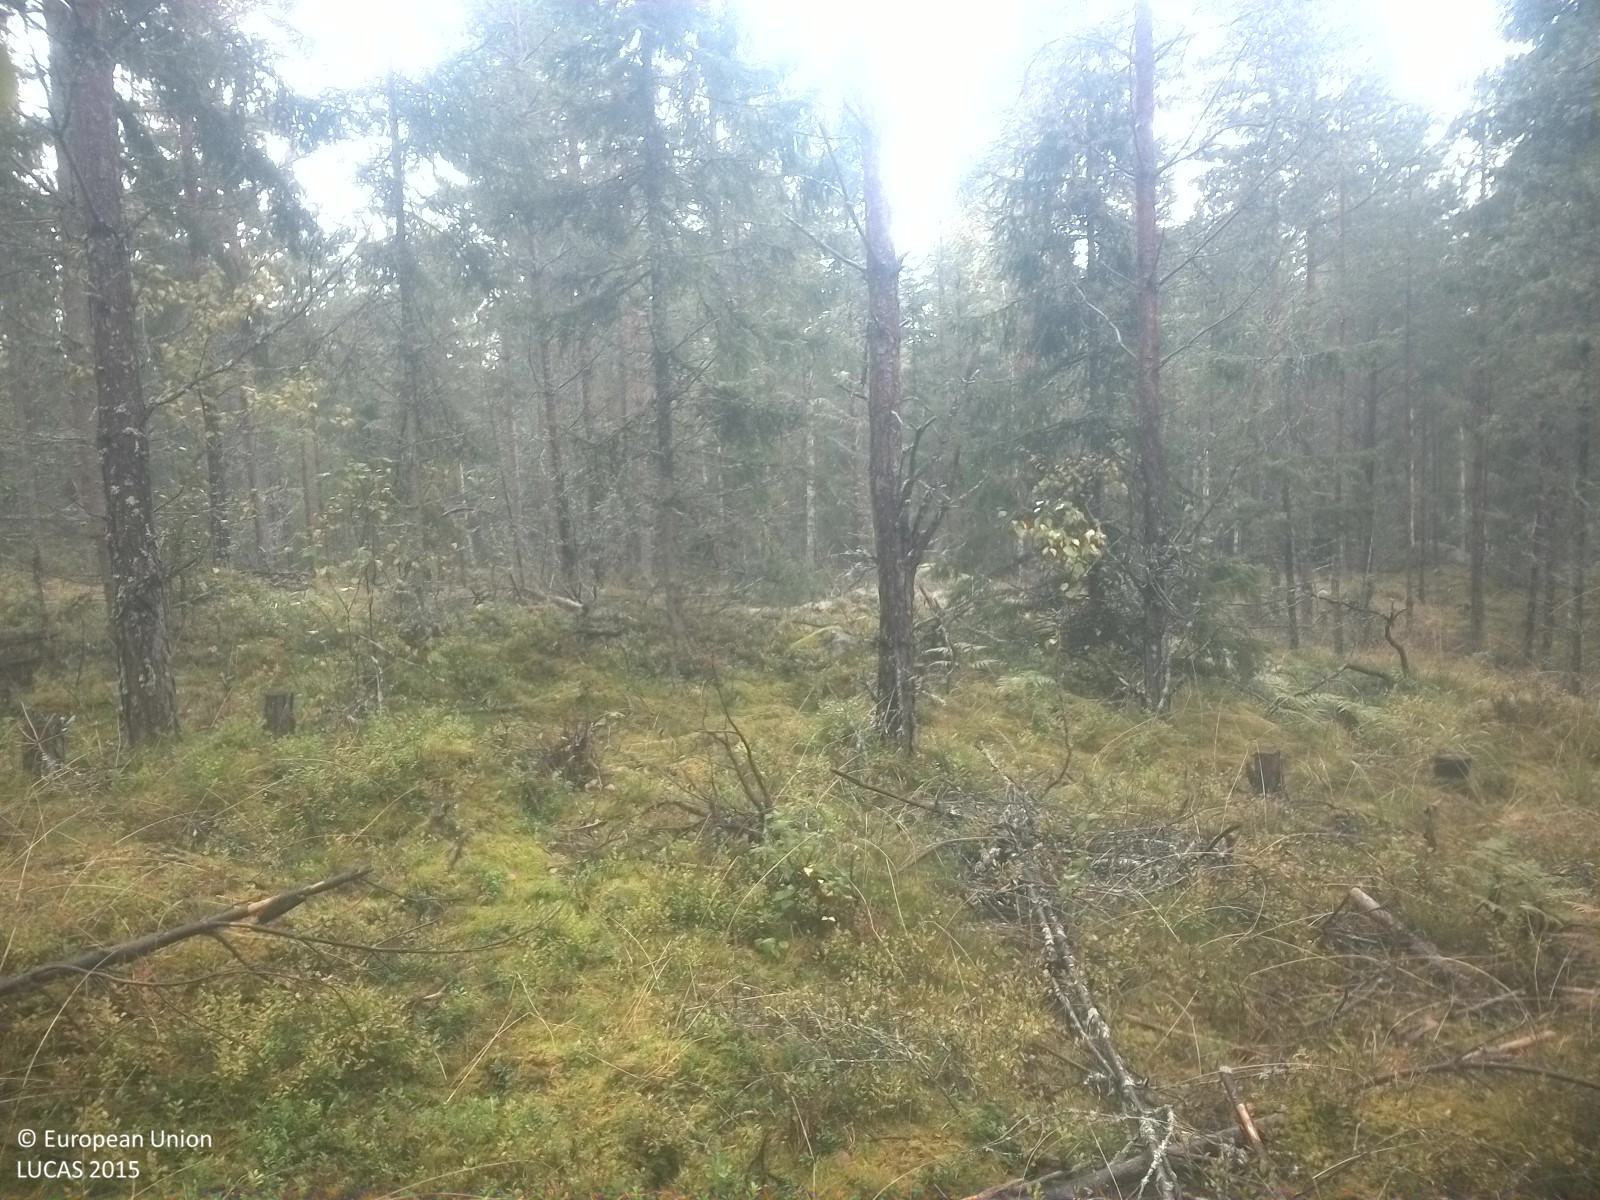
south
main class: Woodland
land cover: Other mixed woodland
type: boreal forest
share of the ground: 25 - 50 %
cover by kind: herbaceous plants 35 %, coniferous forest trees 25 %, lichens and mosses 25 %, broadleaved forest trees 15 %
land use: Forestry
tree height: > 5 m
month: September
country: SE
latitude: 58.8327
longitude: 15.8316
